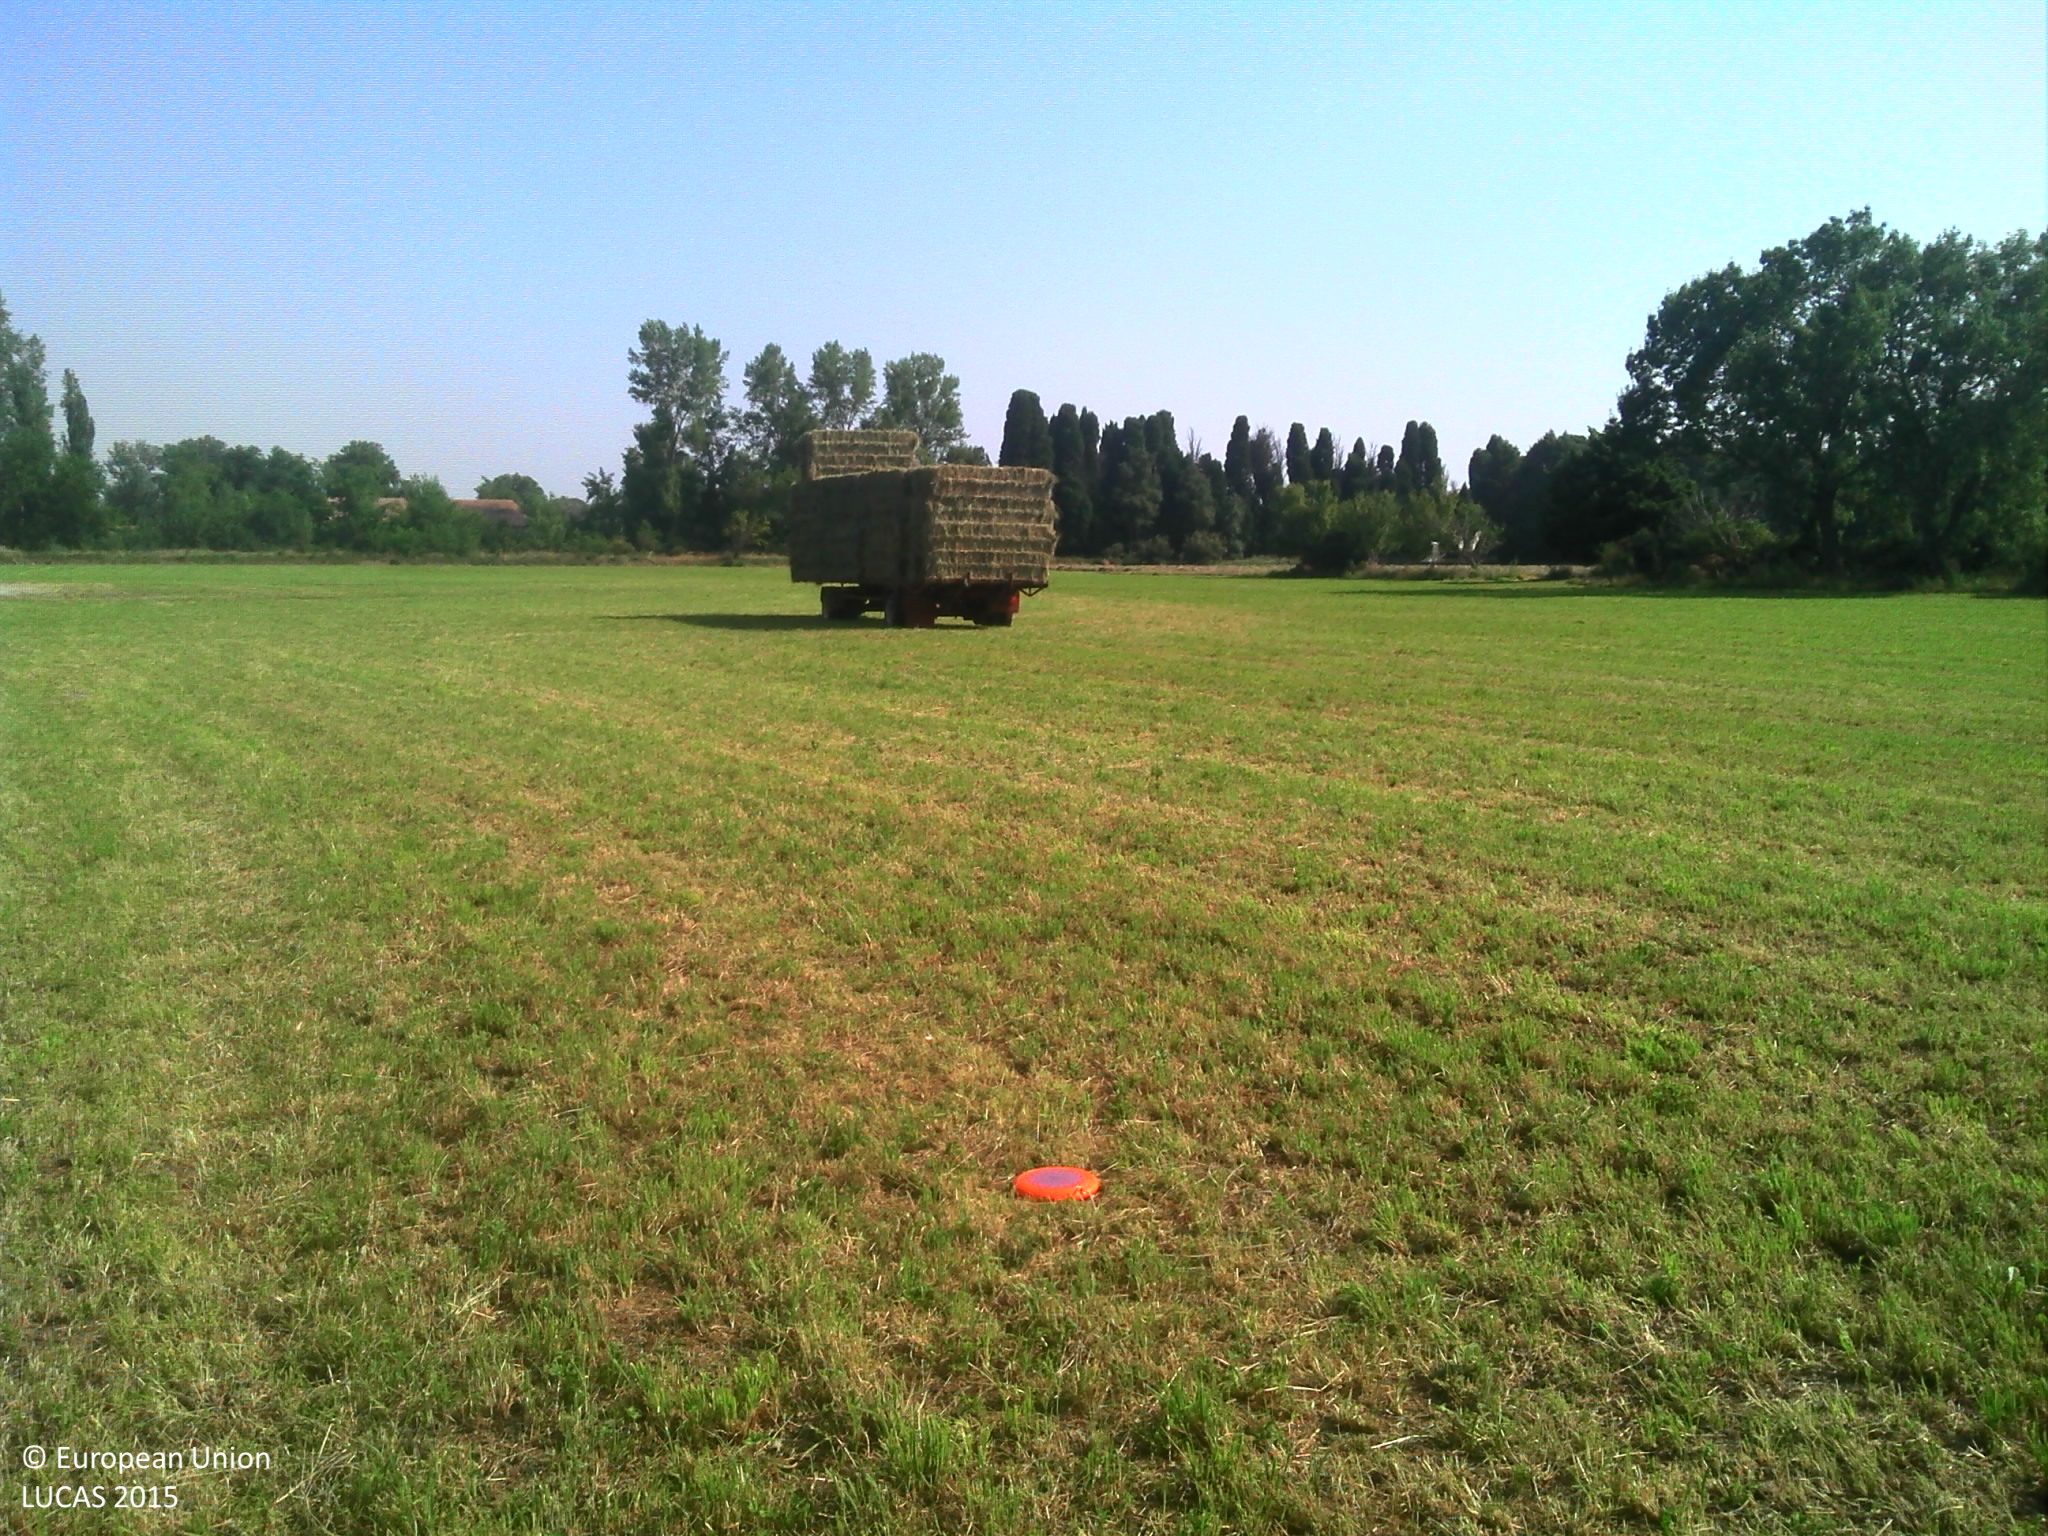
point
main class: Grassland
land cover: Grassland without tree/shrub cover
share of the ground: > 75 %
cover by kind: herbaceous plants 100 %
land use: Agriculture (excluding fallow land and kitchen gardens)
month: July
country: FR
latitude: 43.6728
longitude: 5.0607
